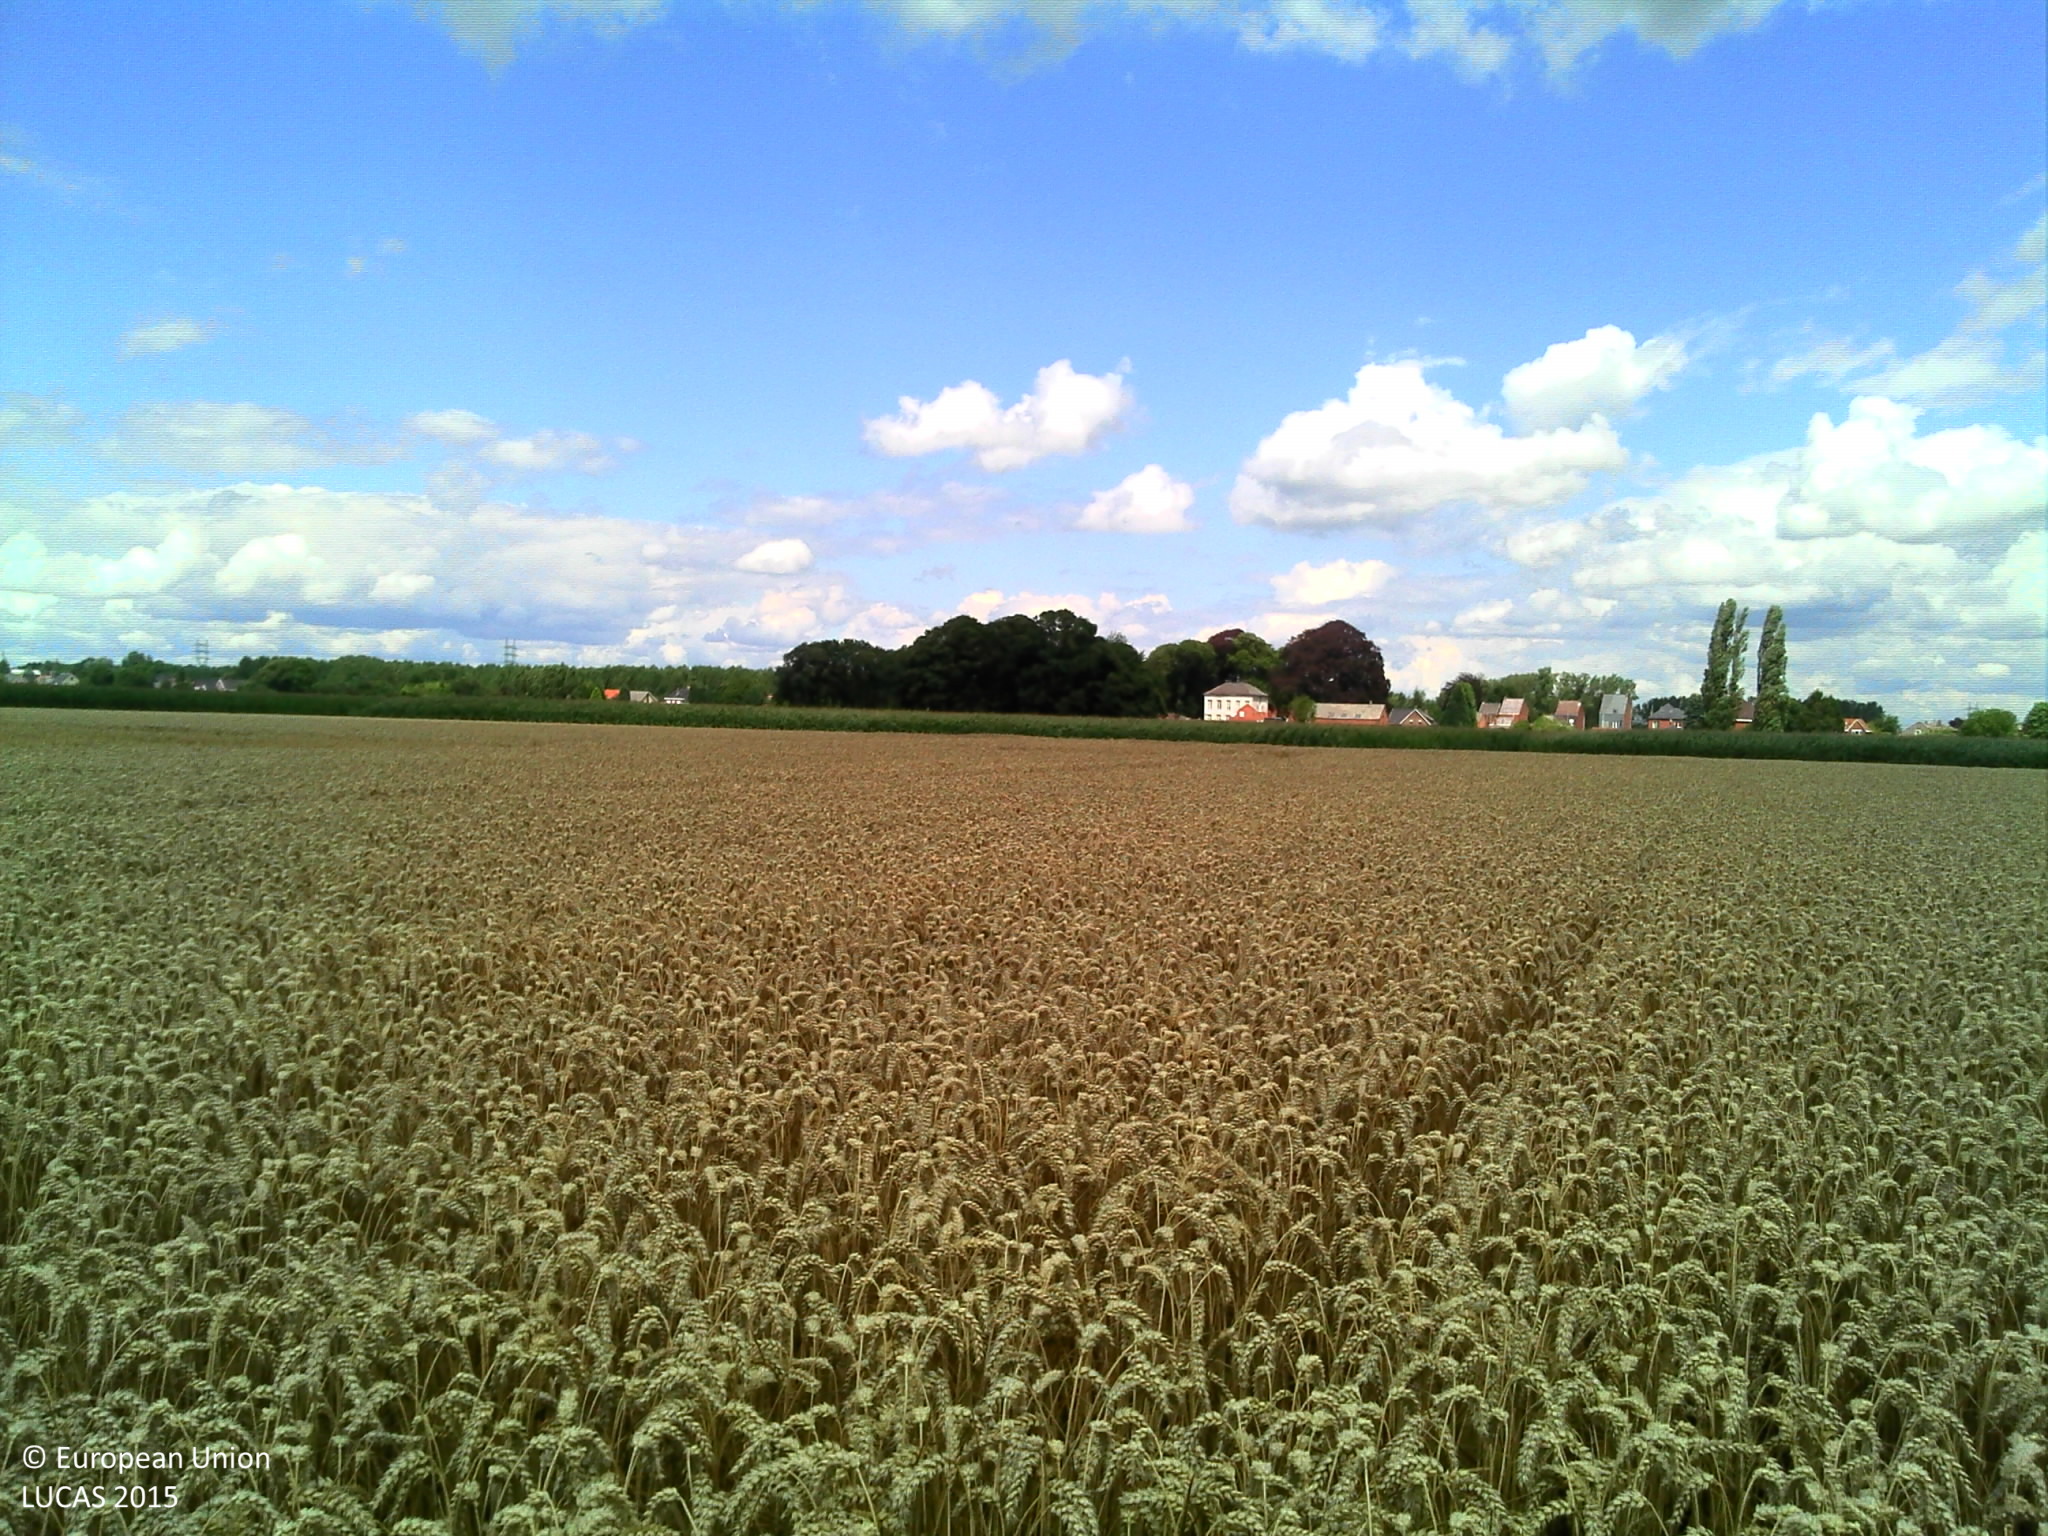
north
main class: Cropland
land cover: Common wheat
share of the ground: > 75 %
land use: Agriculture (excluding fallow land and kitchen gardens)
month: July
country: BE
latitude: 51.0210
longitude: 4.4214
